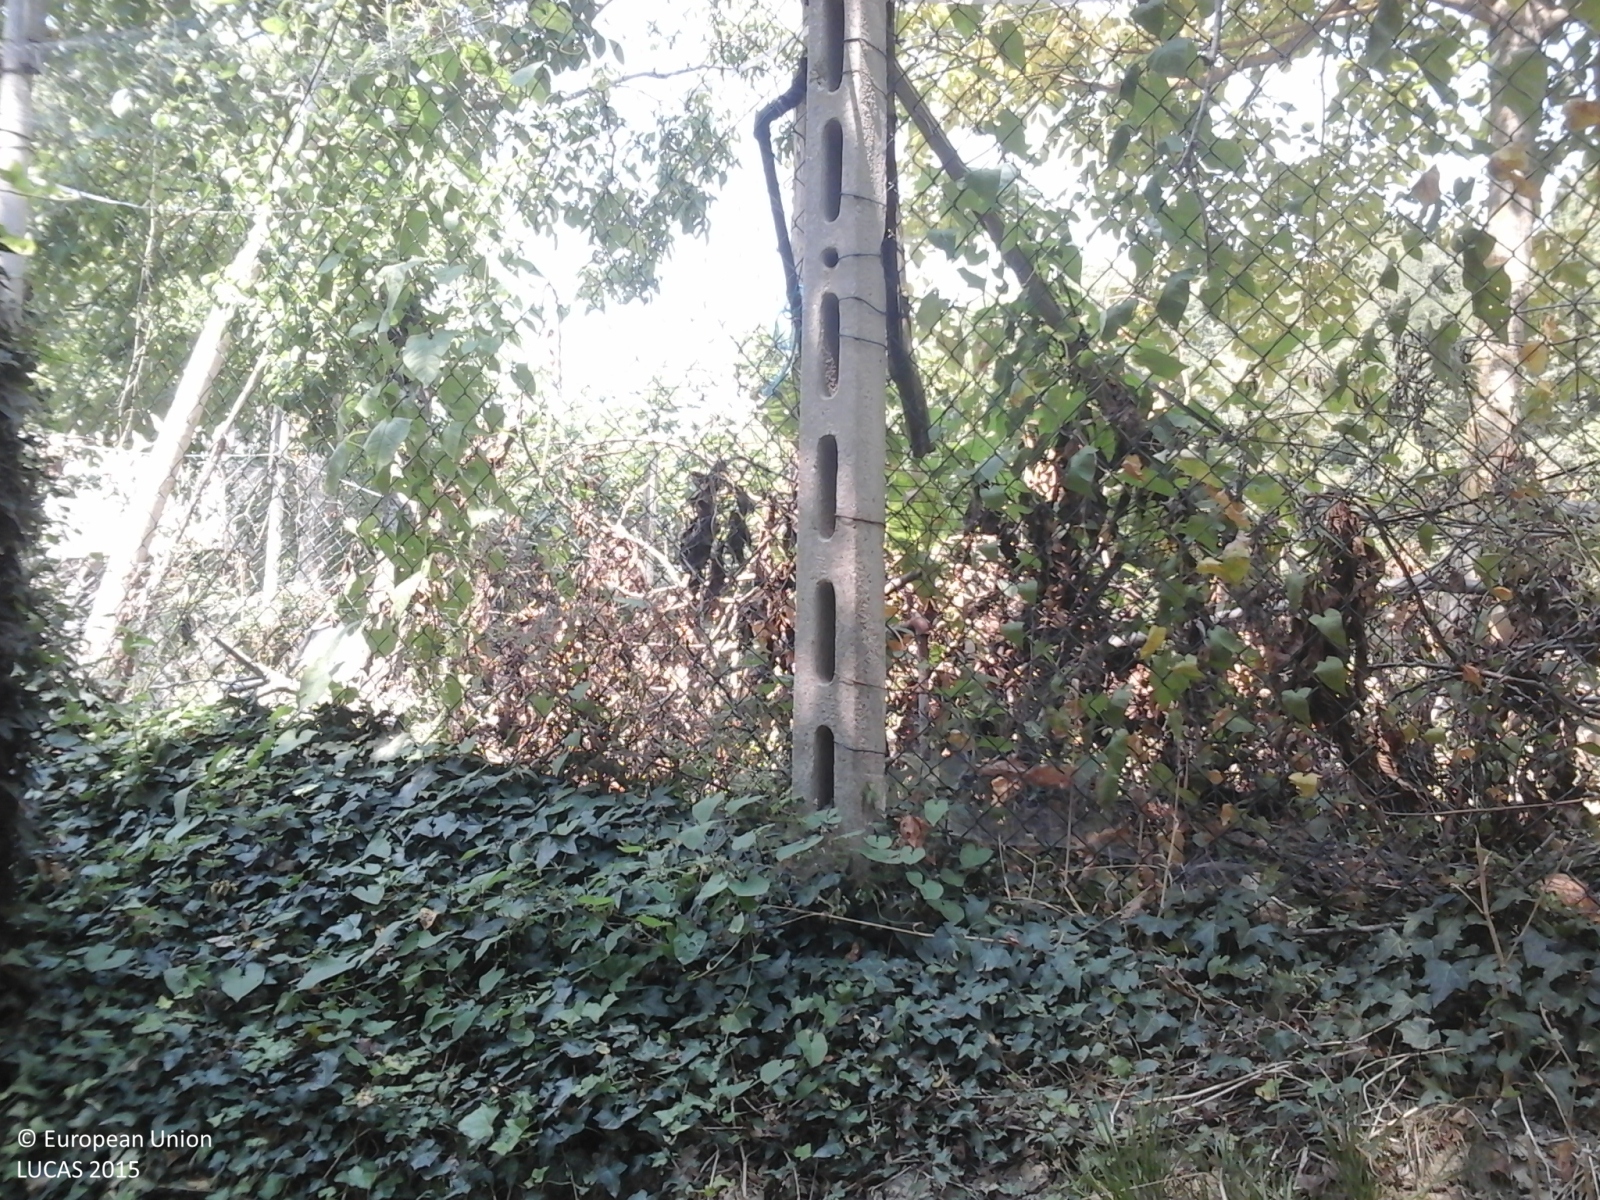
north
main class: Cropland
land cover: Nuts trees
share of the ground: > 75 %
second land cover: Other bare soil
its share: > 75 %
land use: Kitchen garden
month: July
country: IT
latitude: 42.9736
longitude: 13.4849
